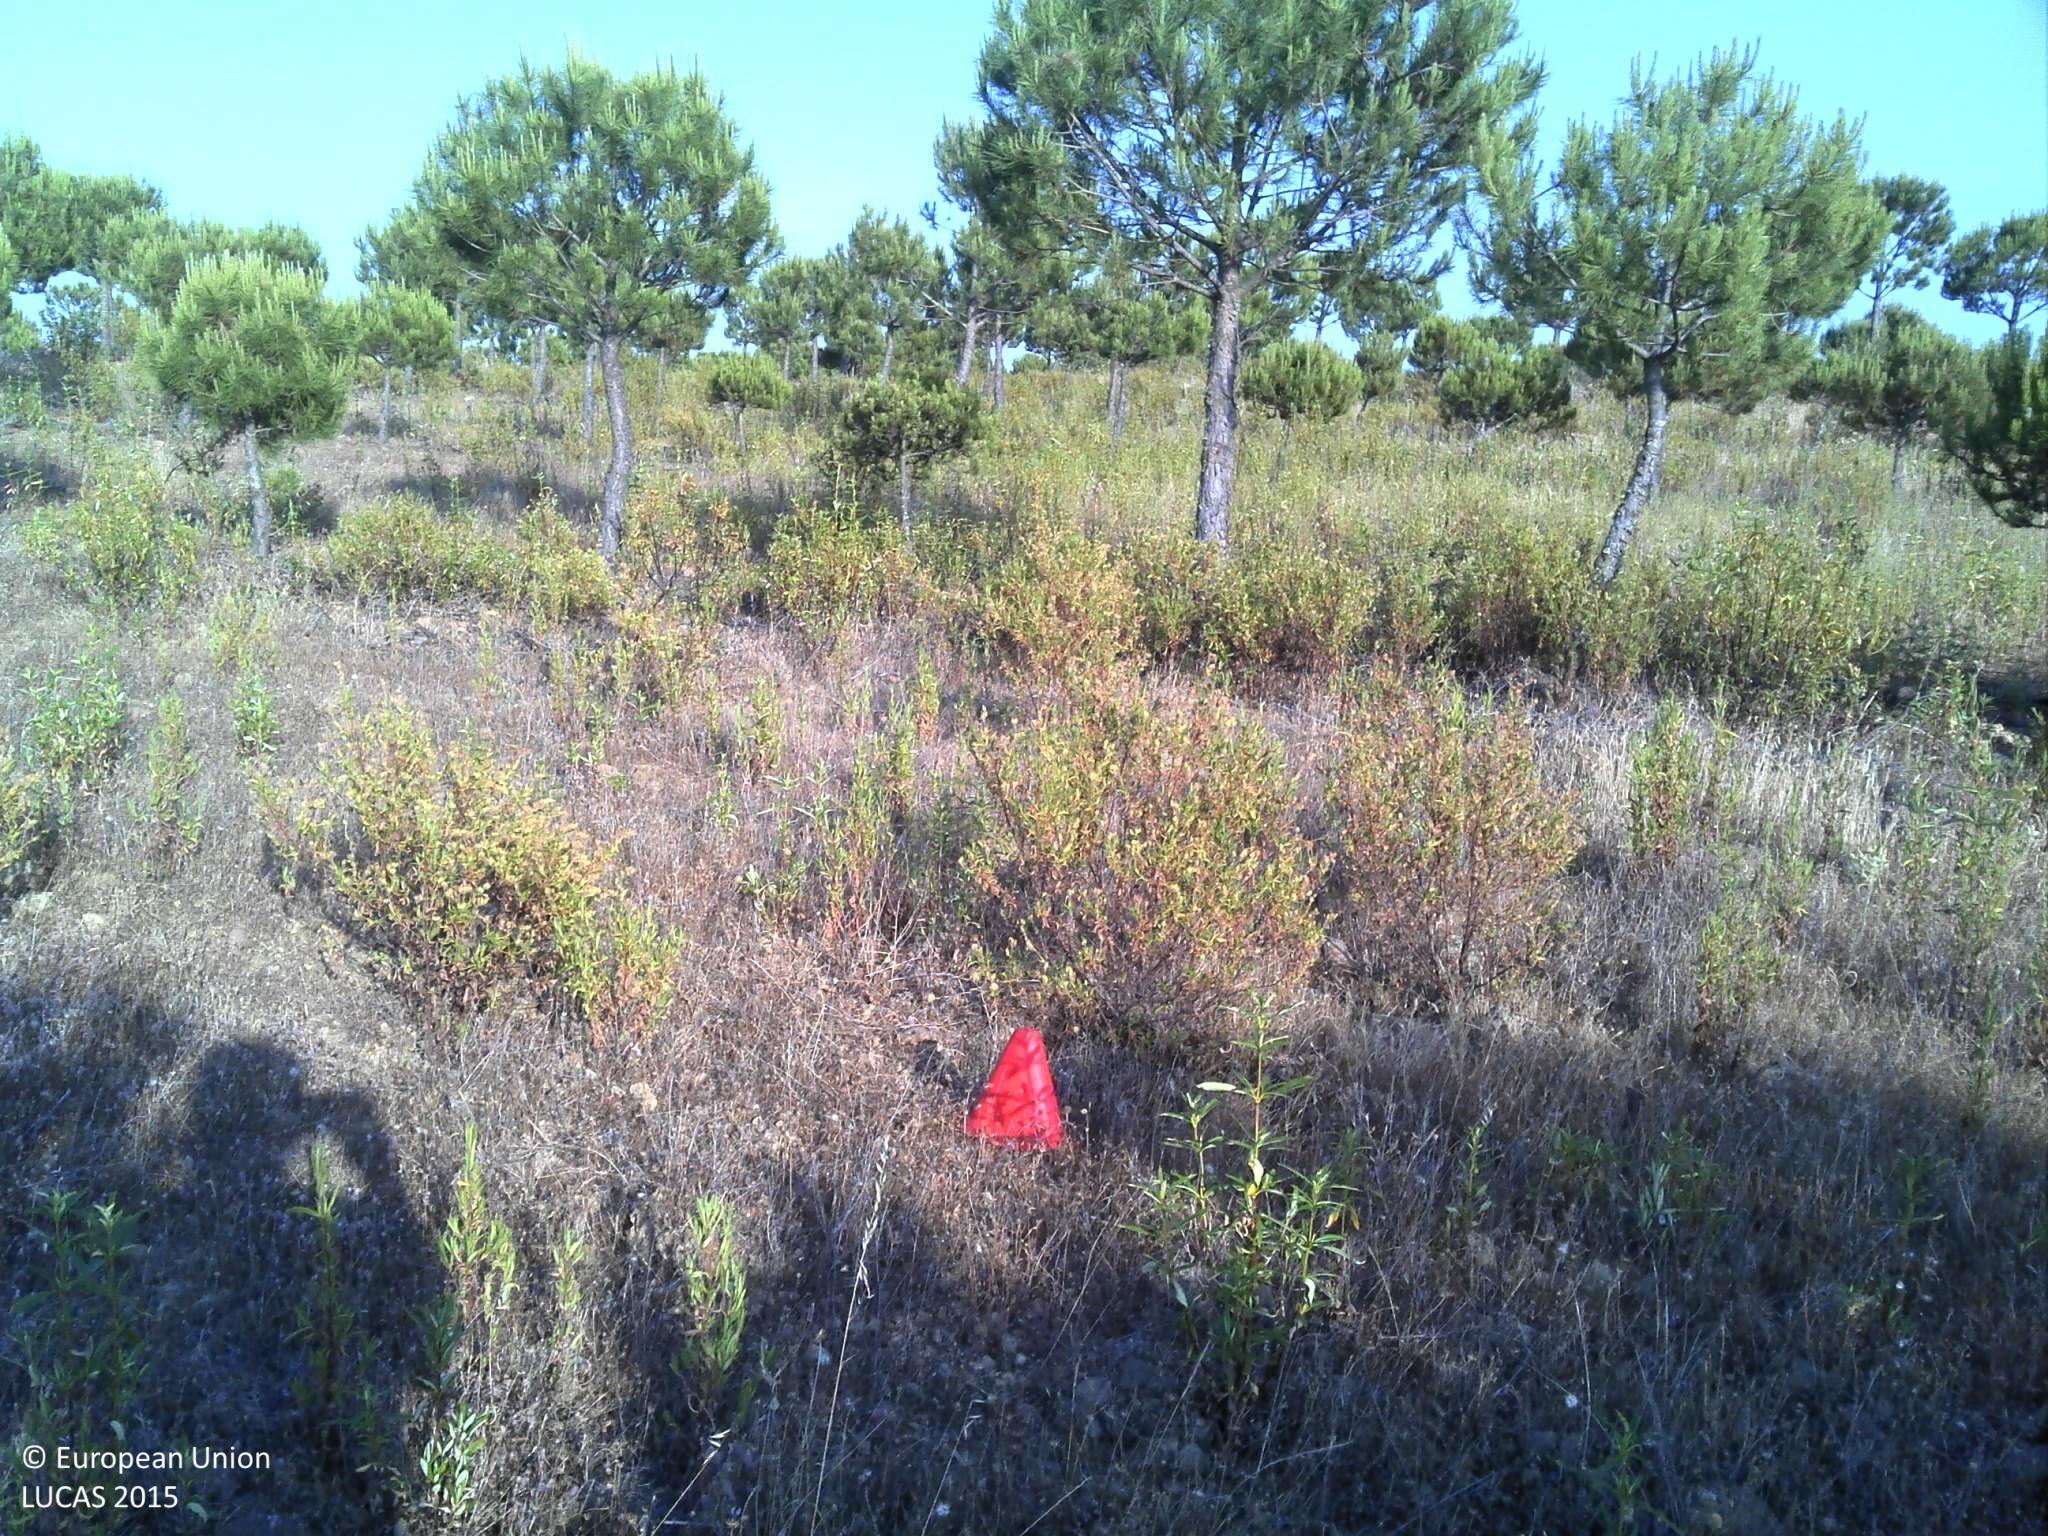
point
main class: Woodland
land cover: Pine dominated coniferous woodland
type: coniferous forest of the mediterranean region
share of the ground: 10 - 25 %
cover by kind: herbaceous plants 50 %, coniferous forest trees 25 %, shrubs 25 %
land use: Forestry
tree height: < 5 m
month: May
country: PT
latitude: 37.4334
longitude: -7.7453
